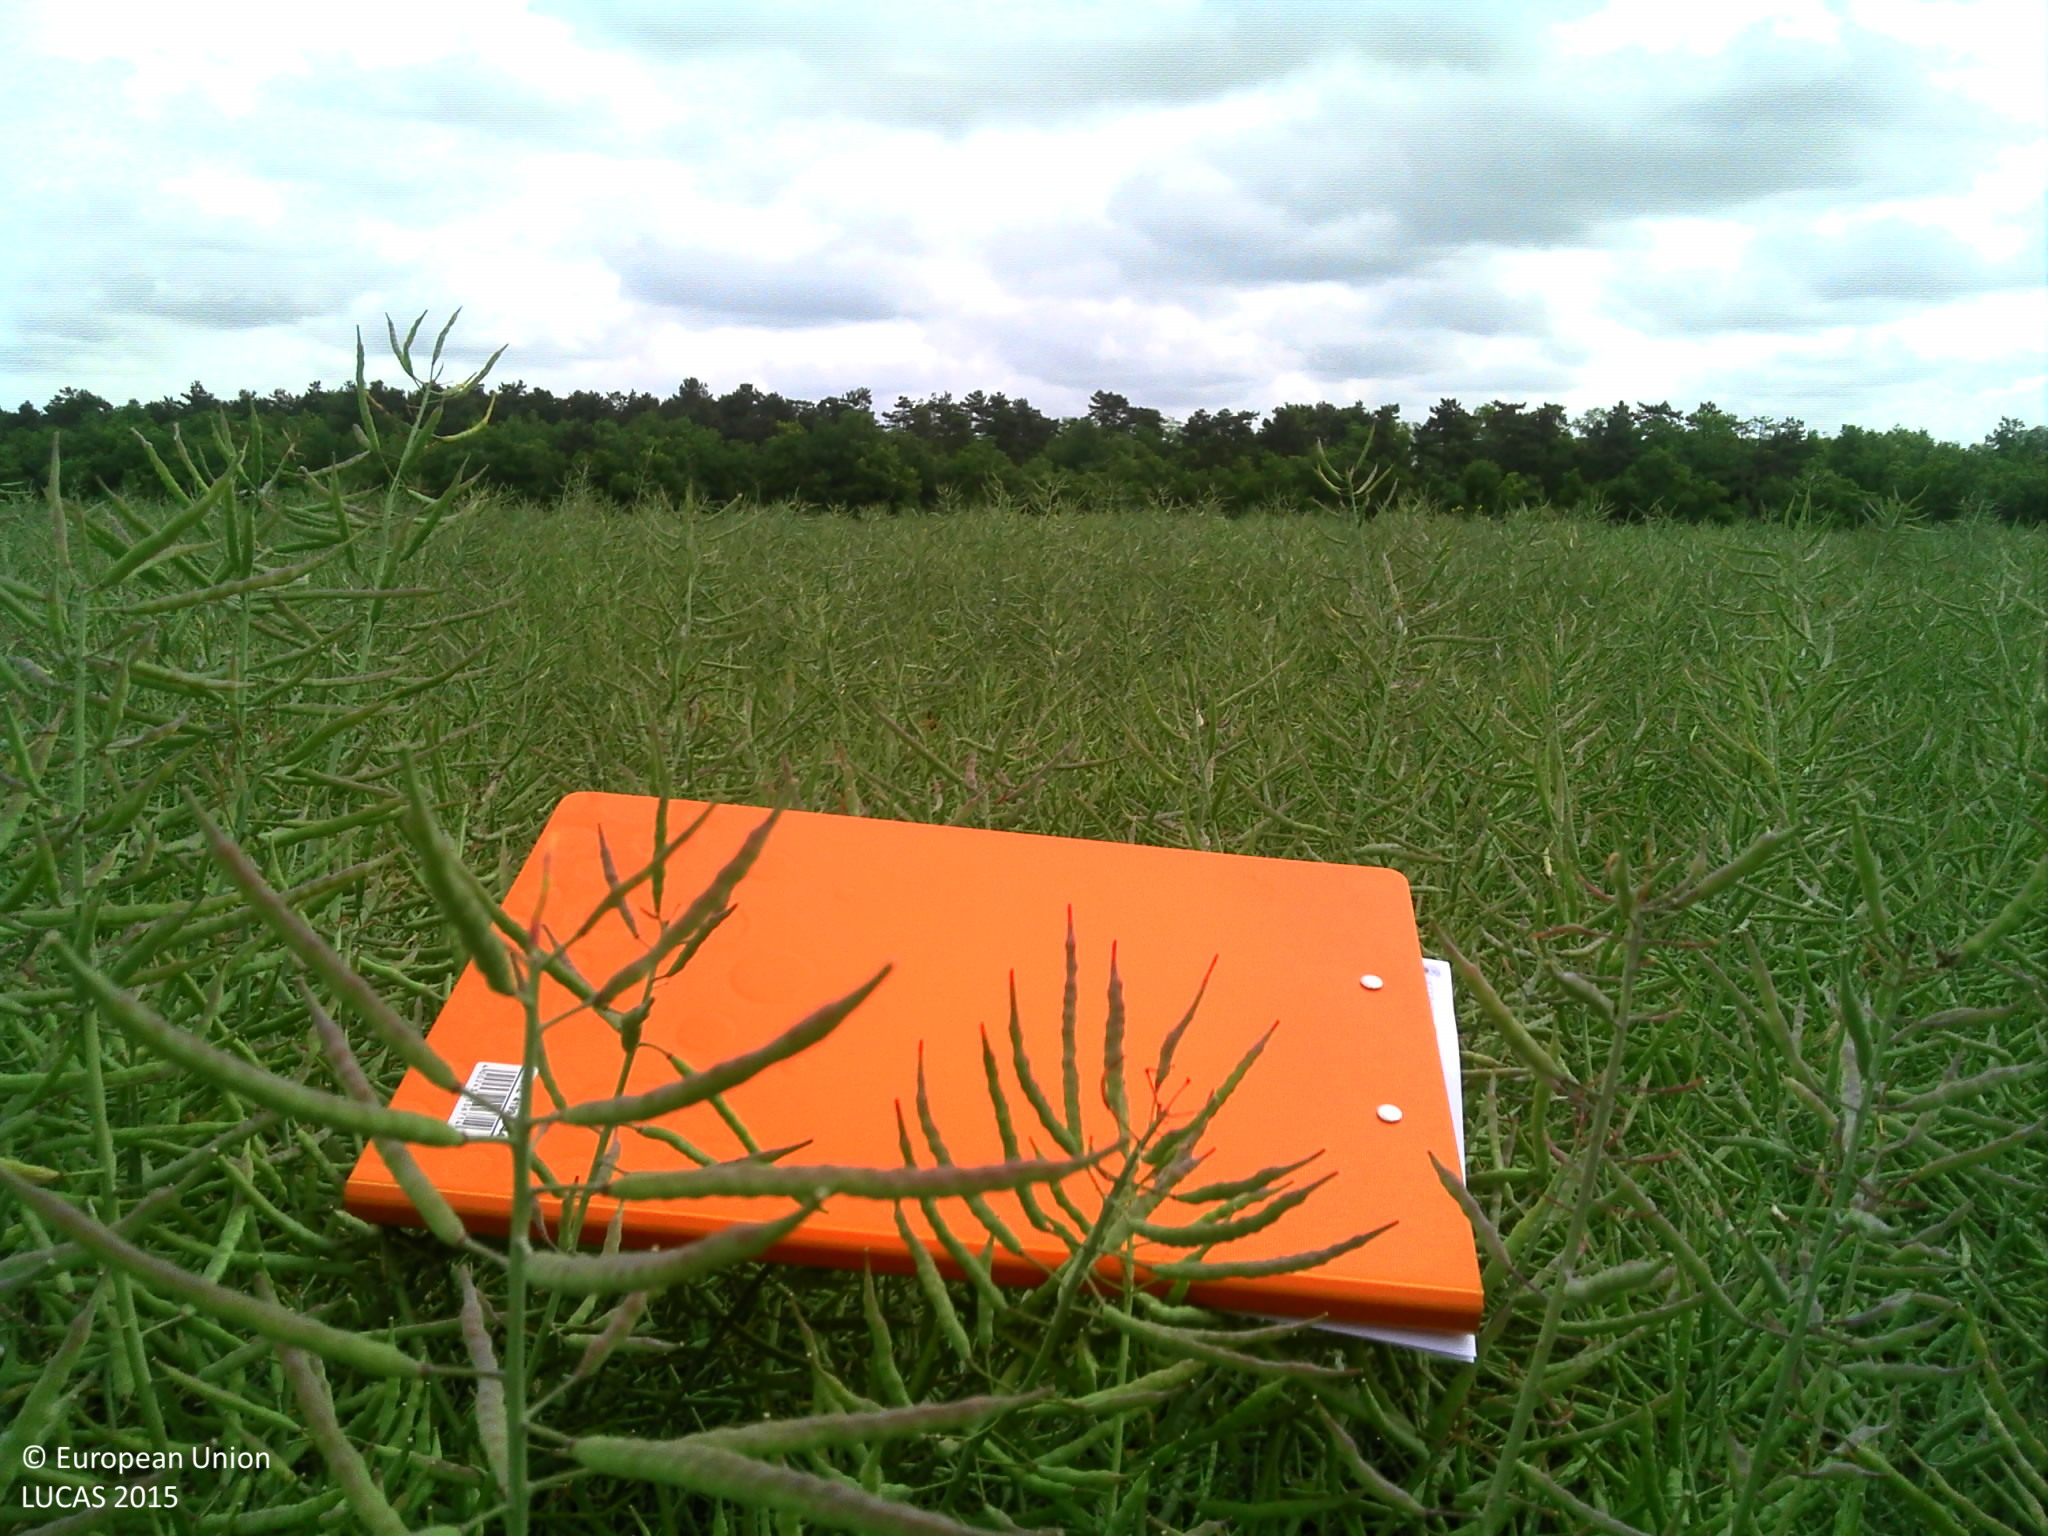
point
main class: Cropland
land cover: Rape and turnip rape
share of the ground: > 75 %
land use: Agriculture (excluding fallow land and kitchen gardens)
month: June
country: FR
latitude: 48.3652
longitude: 1.9824
